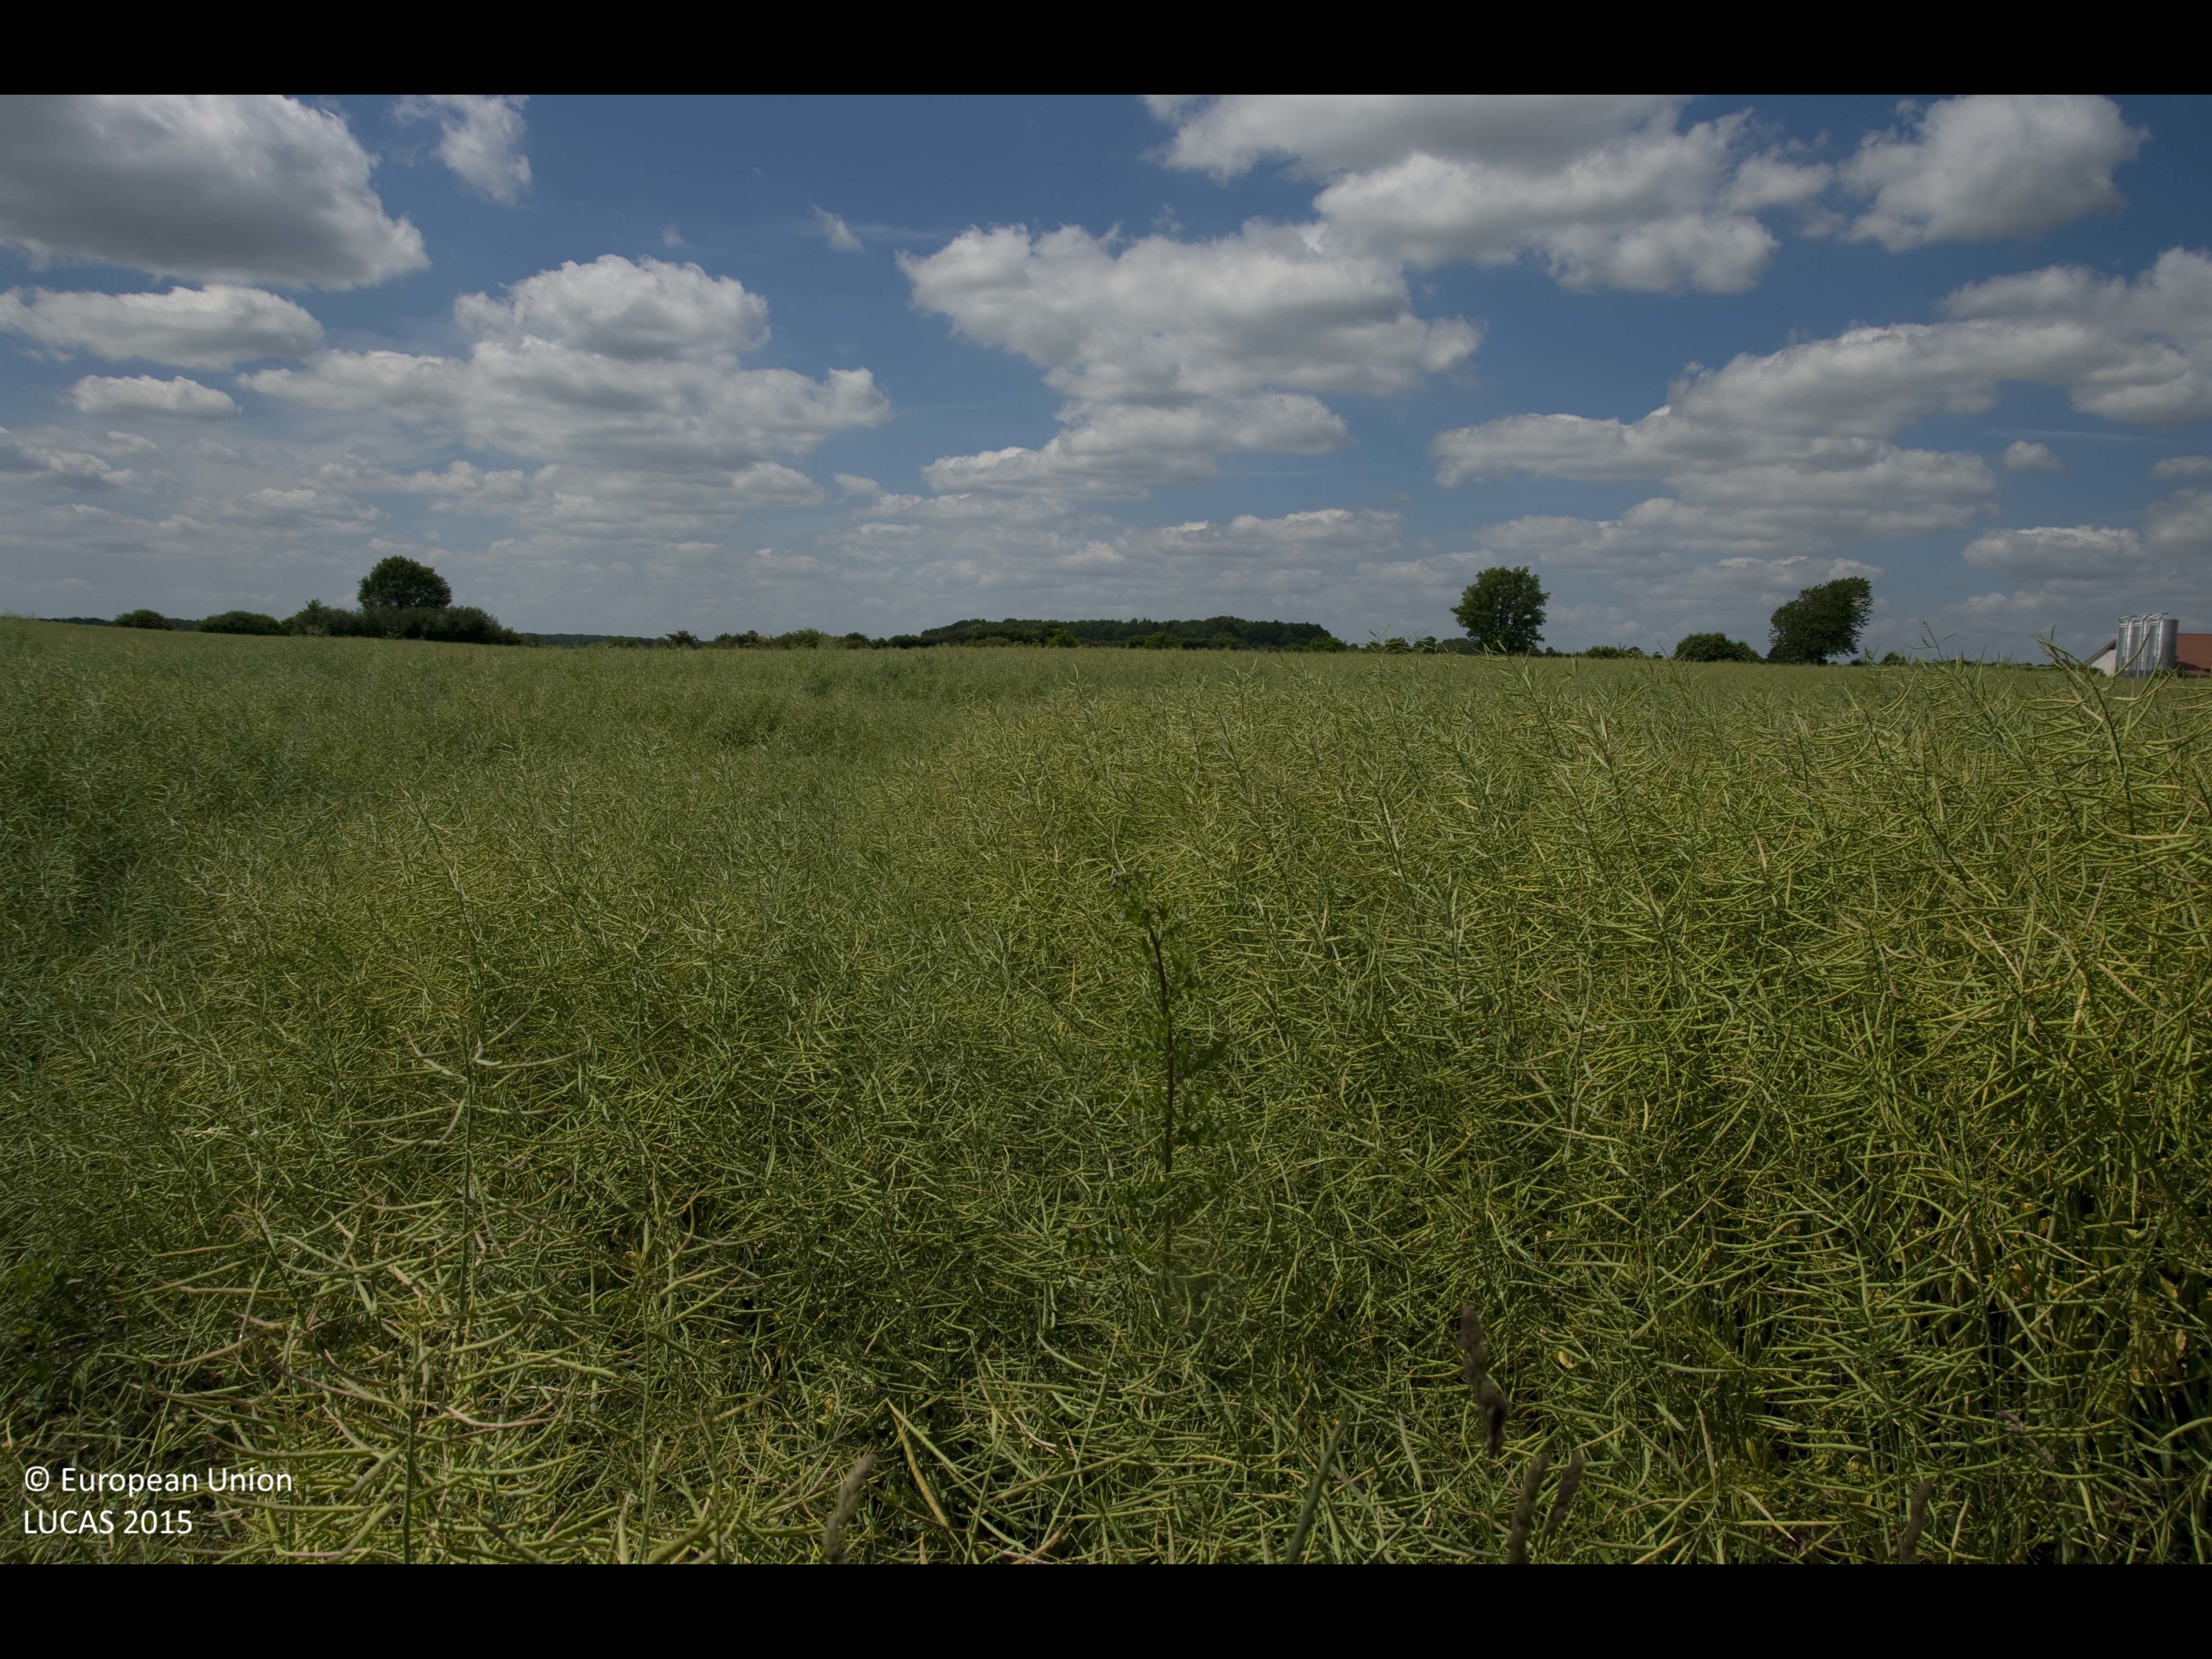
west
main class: Cropland
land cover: Rape and turnip rape
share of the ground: > 75 %
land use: Agriculture (excluding fallow land and kitchen gardens)
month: June
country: DE
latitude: 53.6340
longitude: 10.6197
